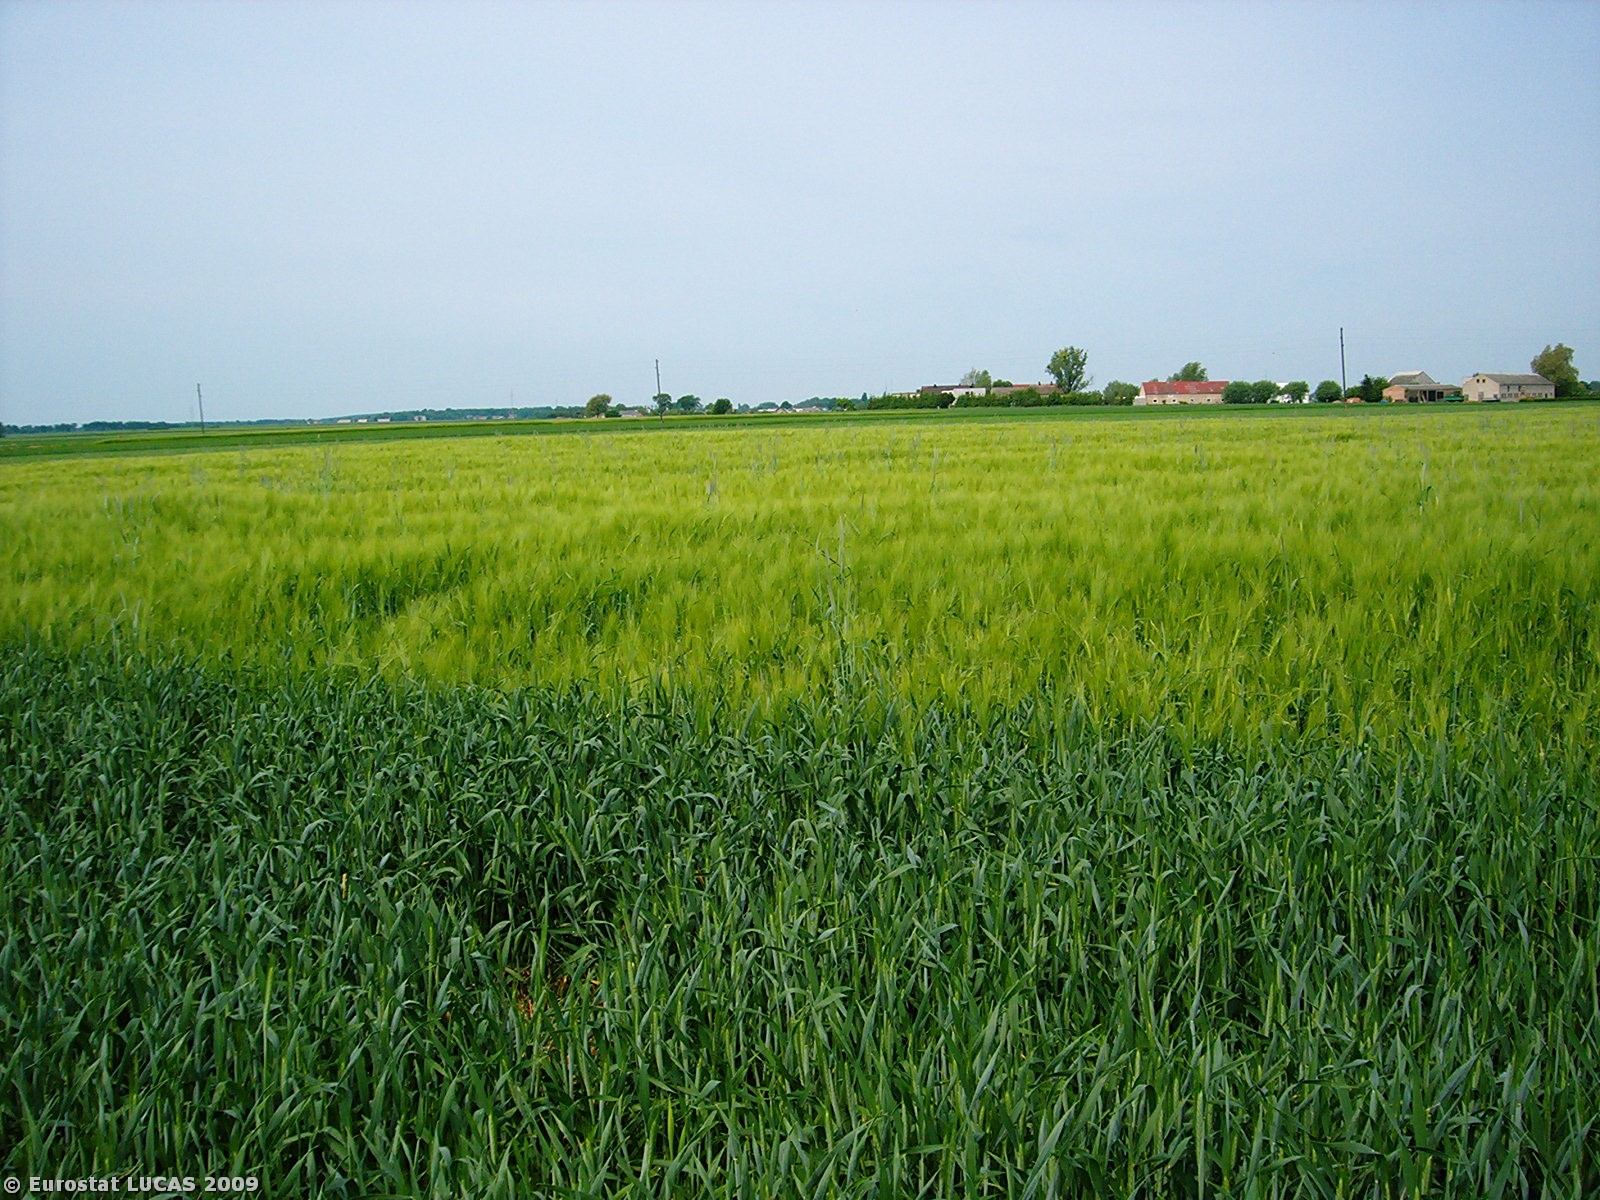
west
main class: Cropland
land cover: Triticale
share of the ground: > 75 %
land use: Agriculture (excluding fallow land and kitchen gardens)
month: May
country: PL
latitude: 52.6747
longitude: 16.3812
